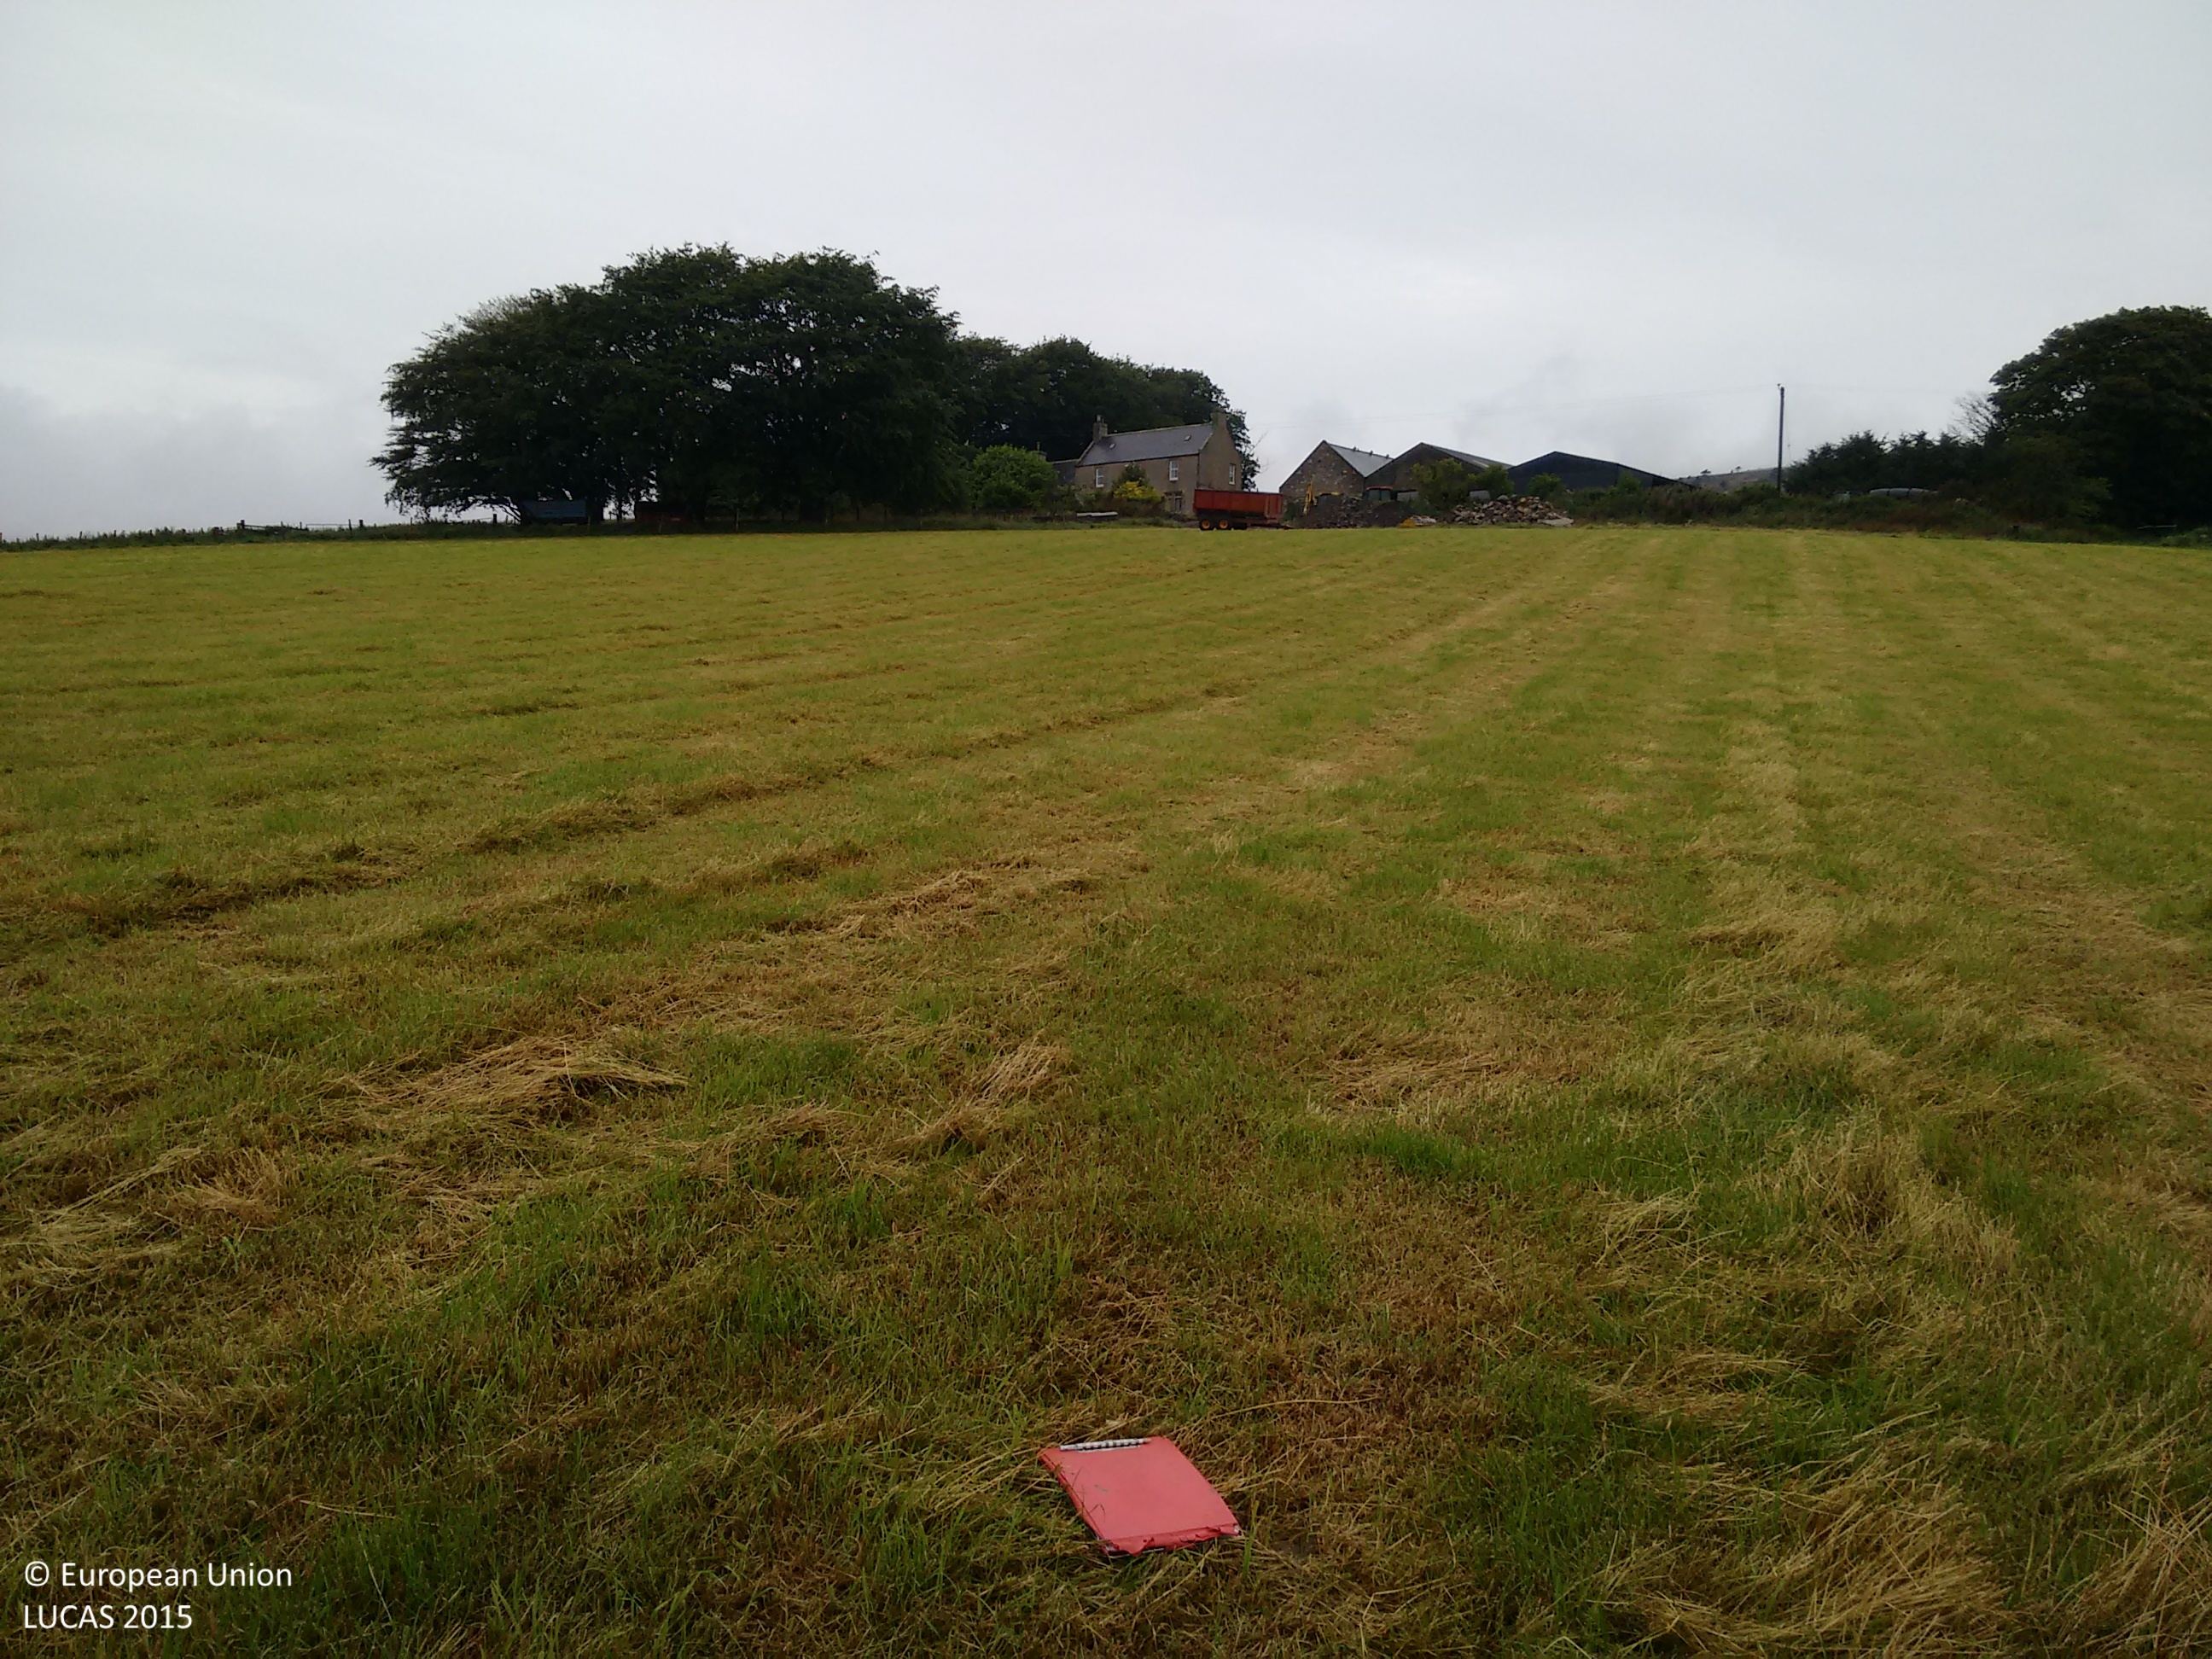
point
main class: Cropland
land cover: Temporary grasslands
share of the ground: > 75 %
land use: Agriculture (excluding fallow land and kitchen gardens)
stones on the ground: < 10 %
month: August
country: GB
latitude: 57.5279
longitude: -2.8336
